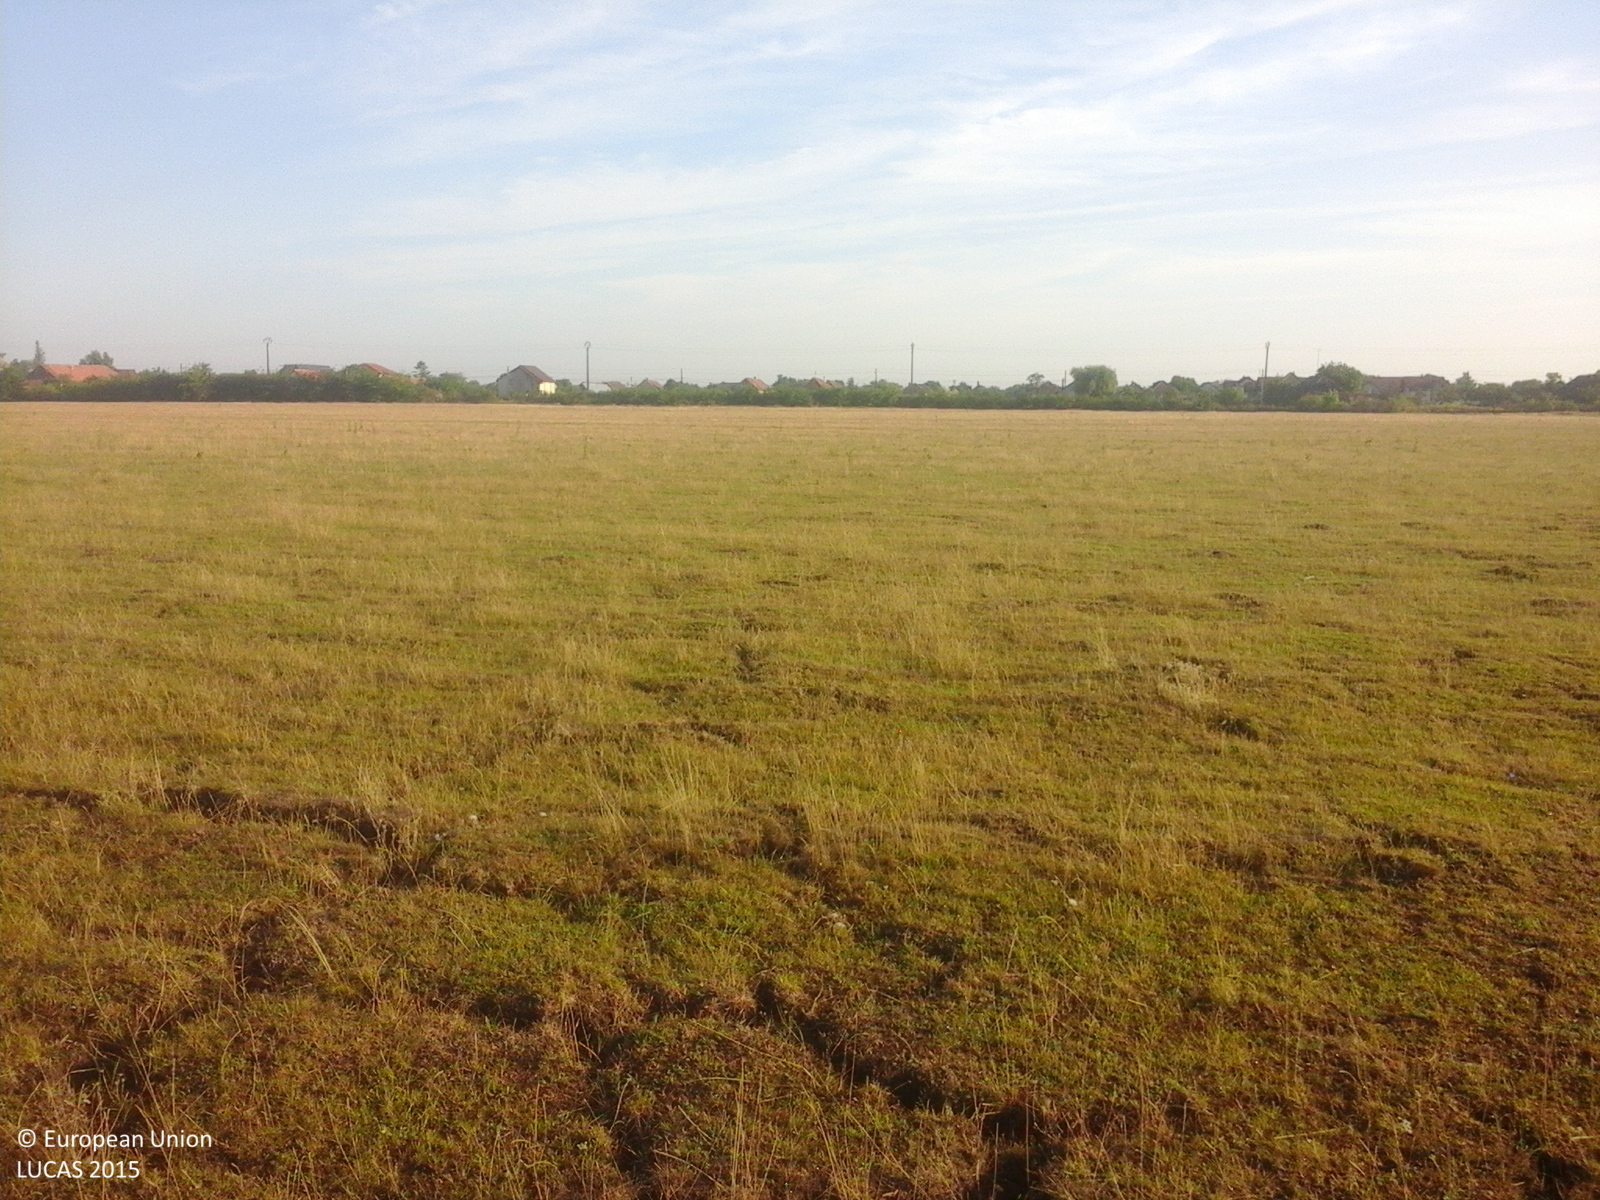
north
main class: Grassland
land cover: Grassland without tree/shrub cover
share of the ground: > 75 %
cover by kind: herbaceous plants 100 %
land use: Agriculture (excluding fallow land and kitchen gardens)
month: August
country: RO
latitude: 45.7056
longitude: 21.0359
